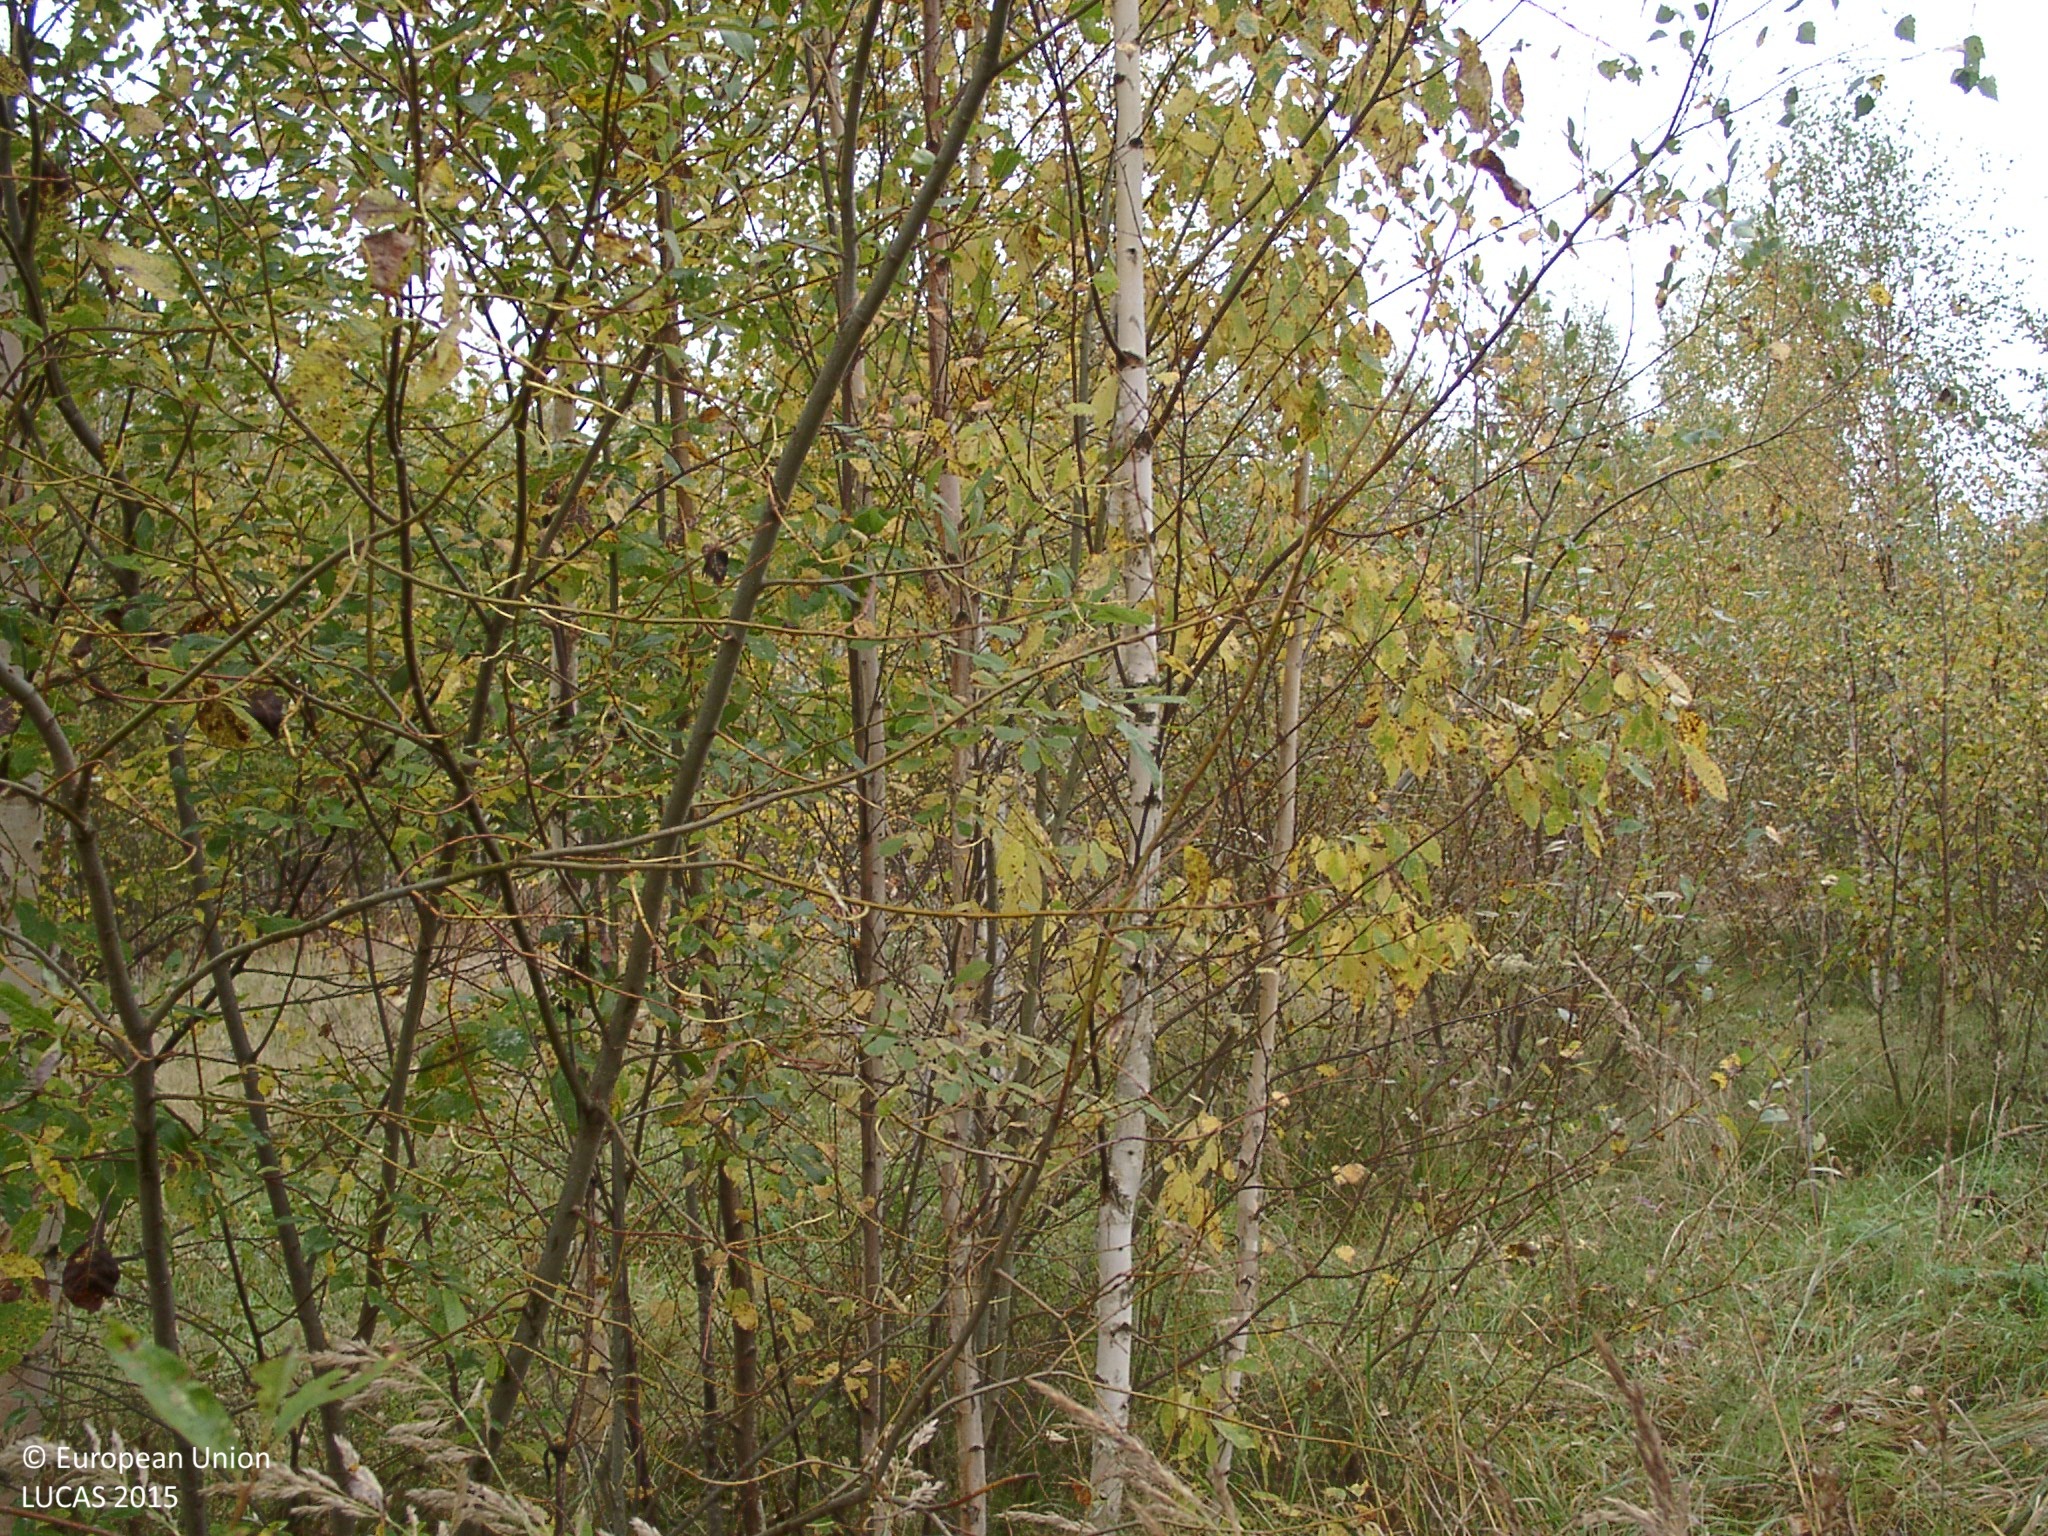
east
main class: Grassland
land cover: Grassland with sparse tree/shrub cover
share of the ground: > 75 %
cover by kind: herbaceous plants 90 %, broadleaved forest trees 5 %, shrubs 5 %
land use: Semi-natural and natural areas not in use
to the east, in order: Grassland with sparse tree/shrub cover; Broadleaved woodland; Ditches and canals; Broadleaved woodland; Ditches and canals; Broadleaved woodland
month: September
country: FI
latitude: 62.7188
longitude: 25.3799
